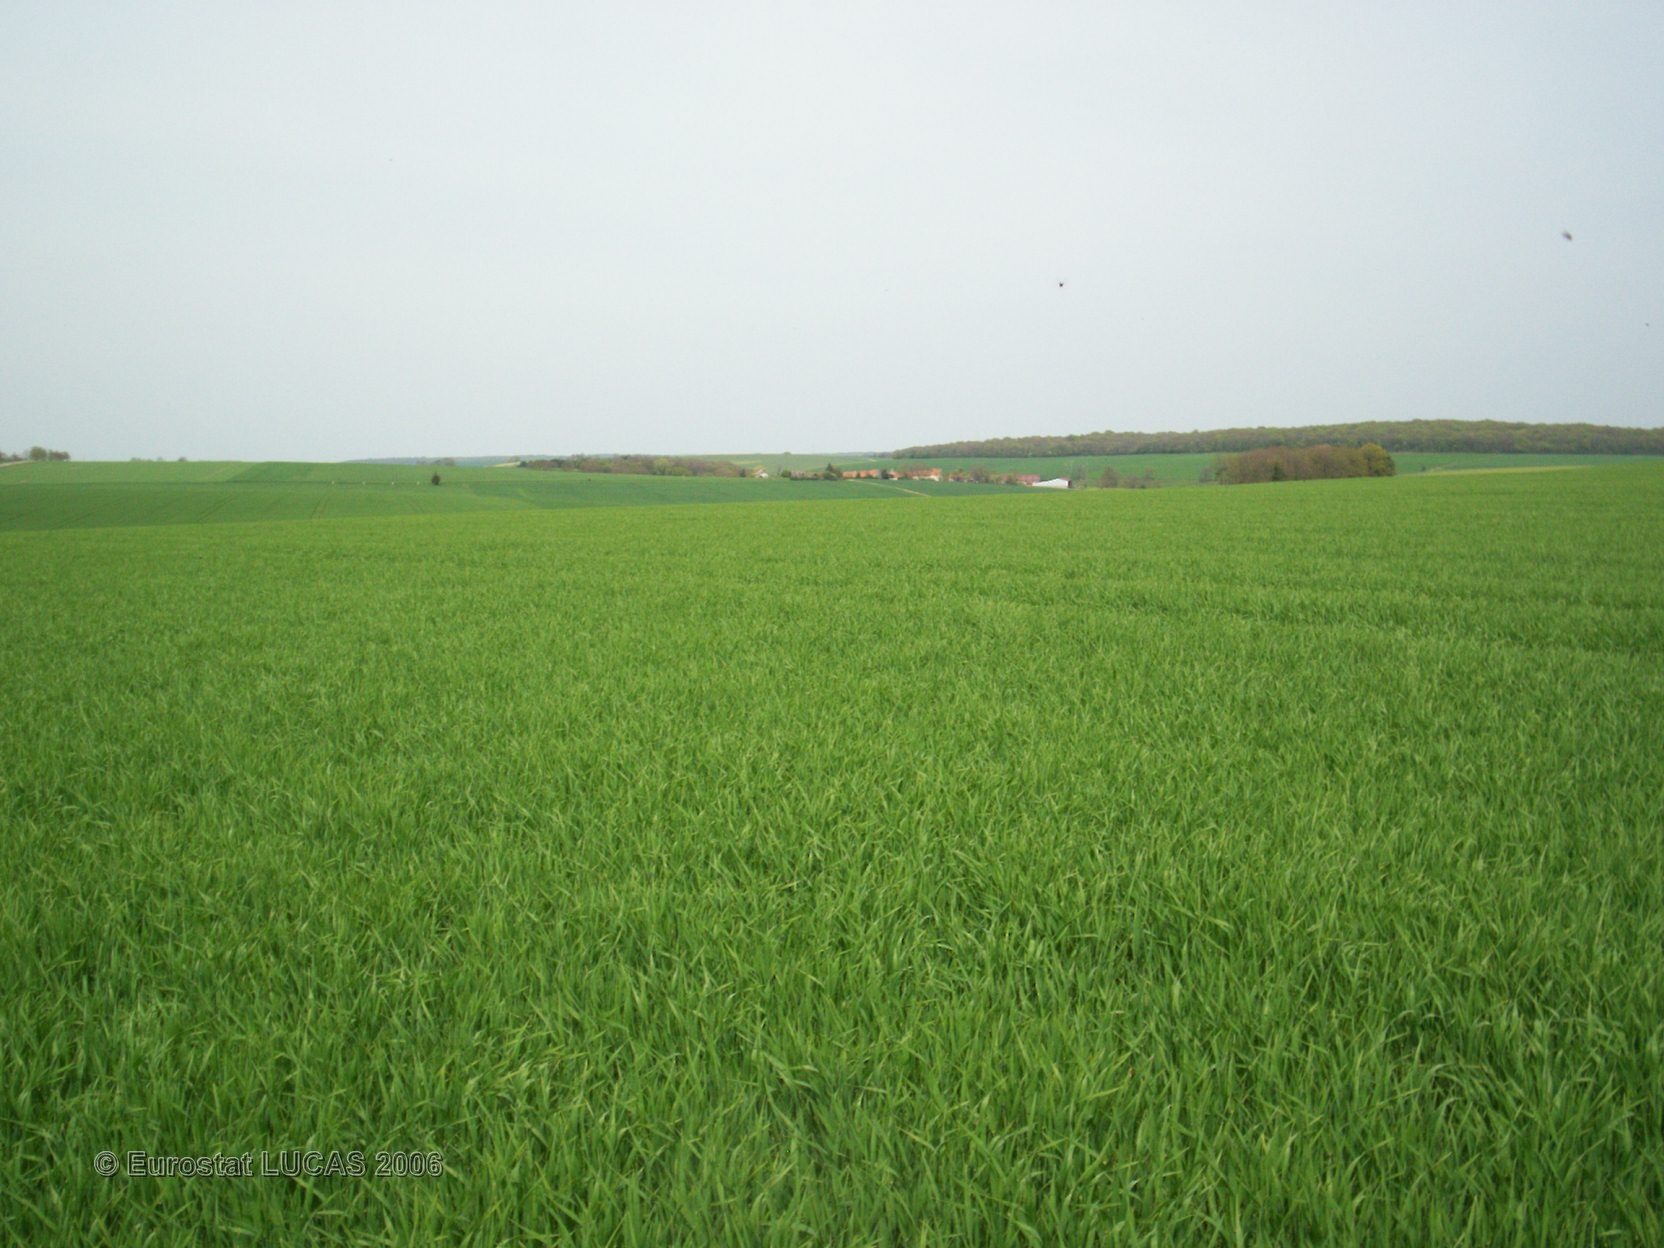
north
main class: Cropland
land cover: Barley
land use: Agriculture (excluding fallow land and kitchen gardens)
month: May
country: FR
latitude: 47.6420
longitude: 4.6347
